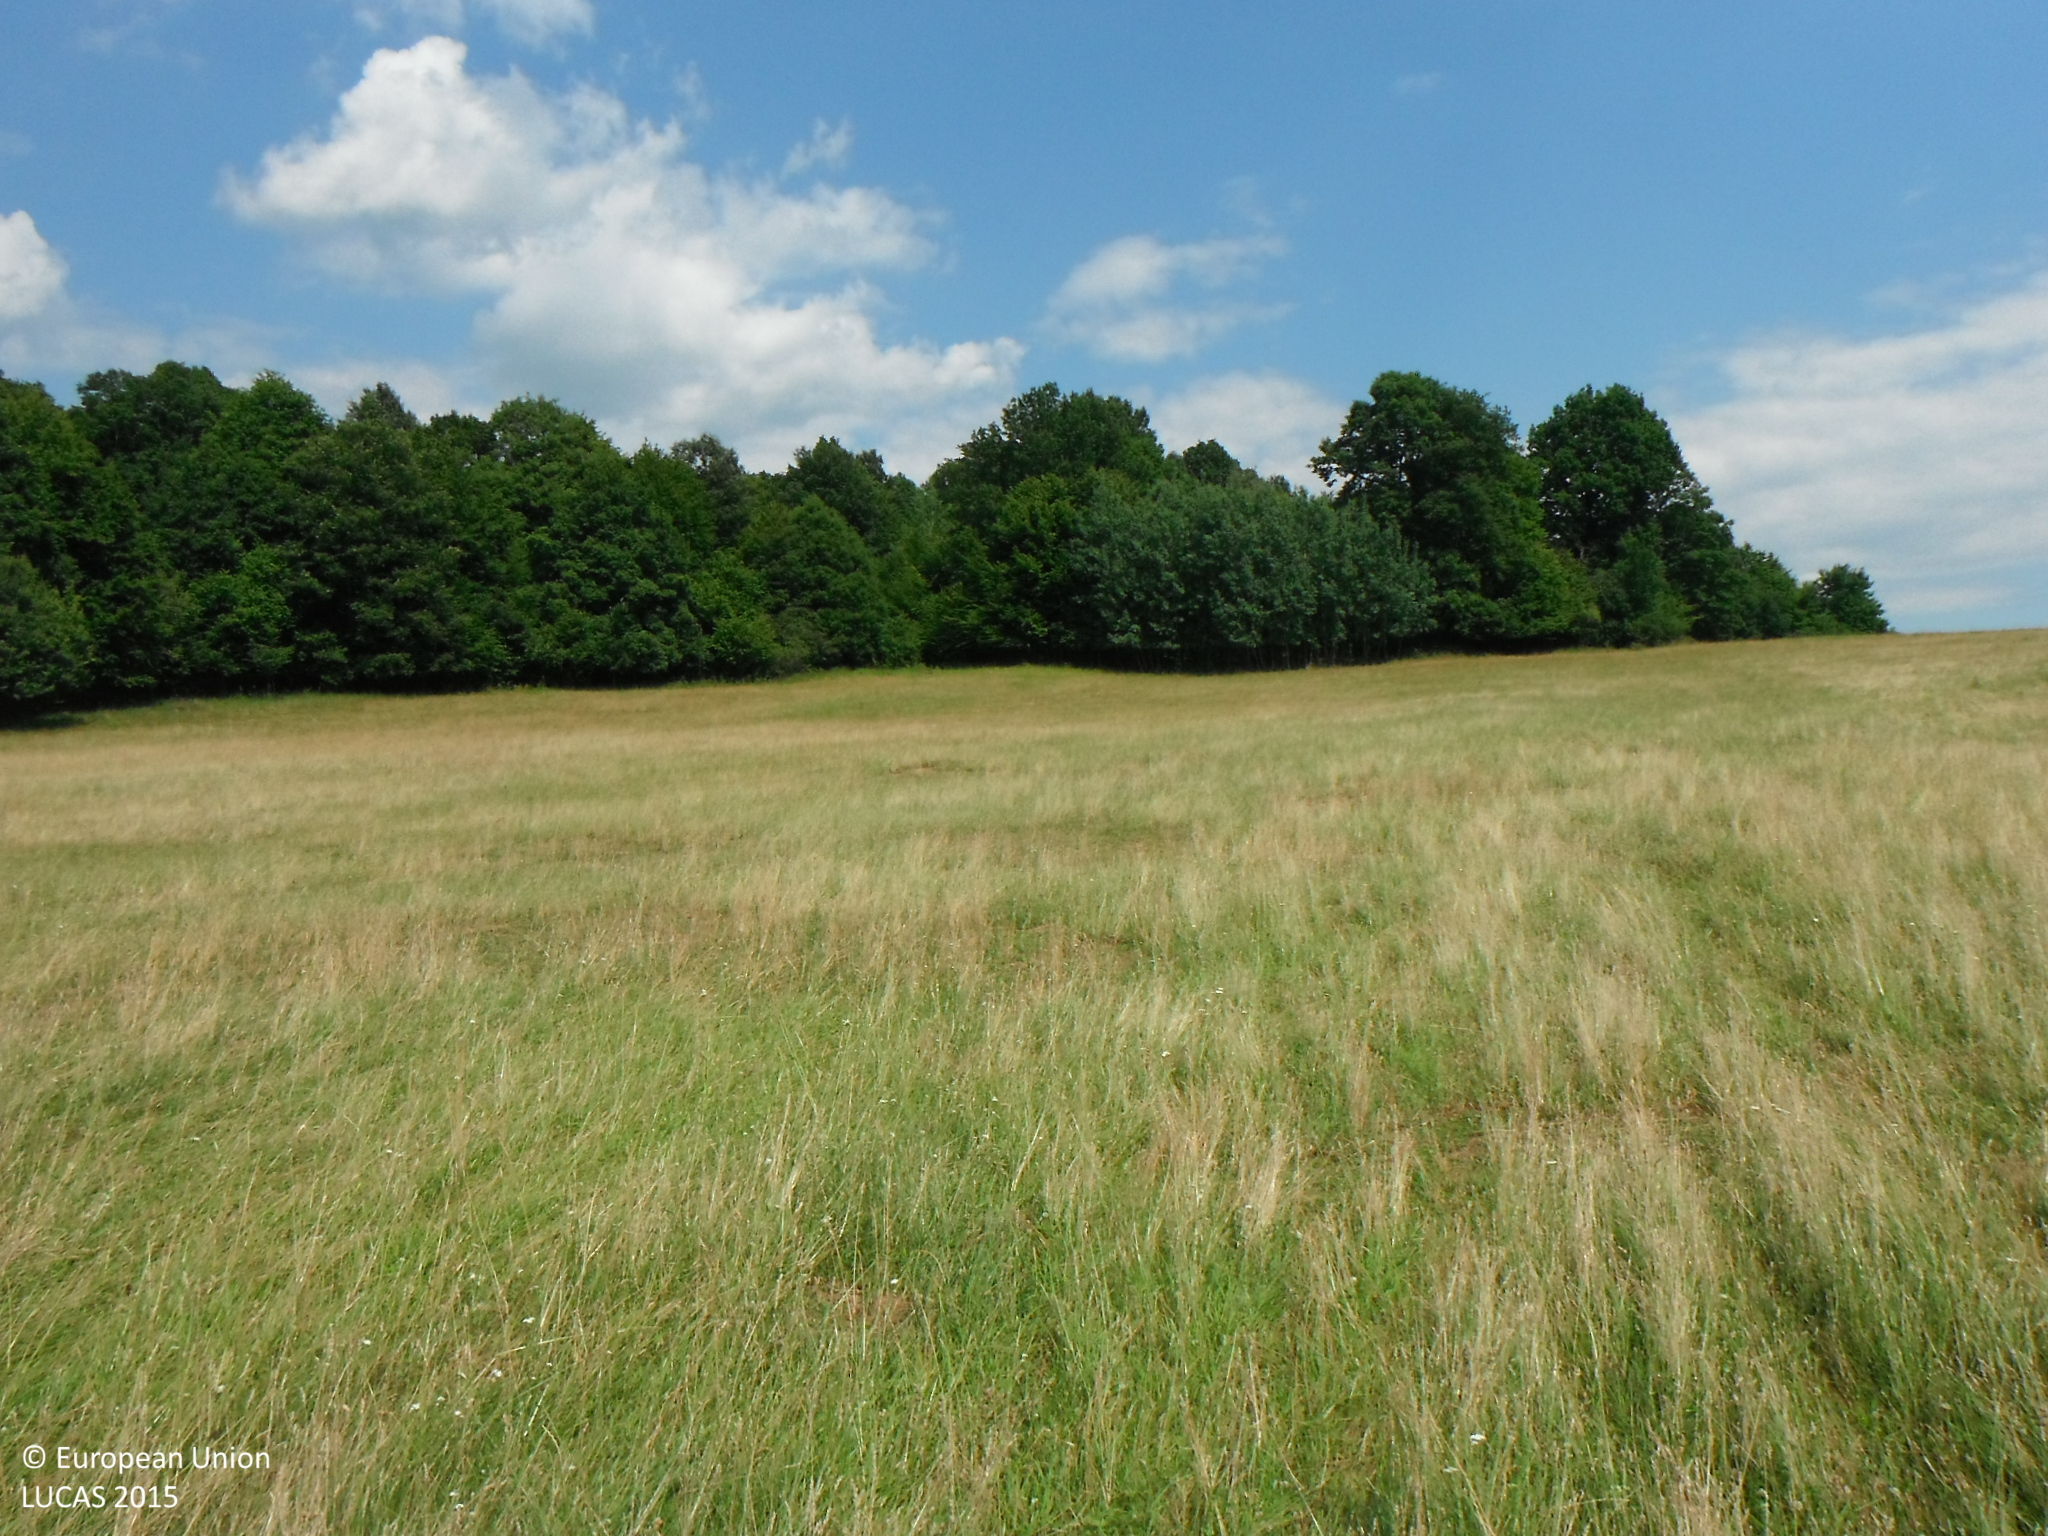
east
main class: Grassland
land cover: Grassland without tree/shrub cover
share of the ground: > 75 %
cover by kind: herbaceous plants 100 %
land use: Agriculture (excluding fallow land and kitchen gardens)
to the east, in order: Grassland without tree/shrub cover; Broadleaved woodland
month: June
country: SK
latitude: 48.5210
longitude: 20.0902
